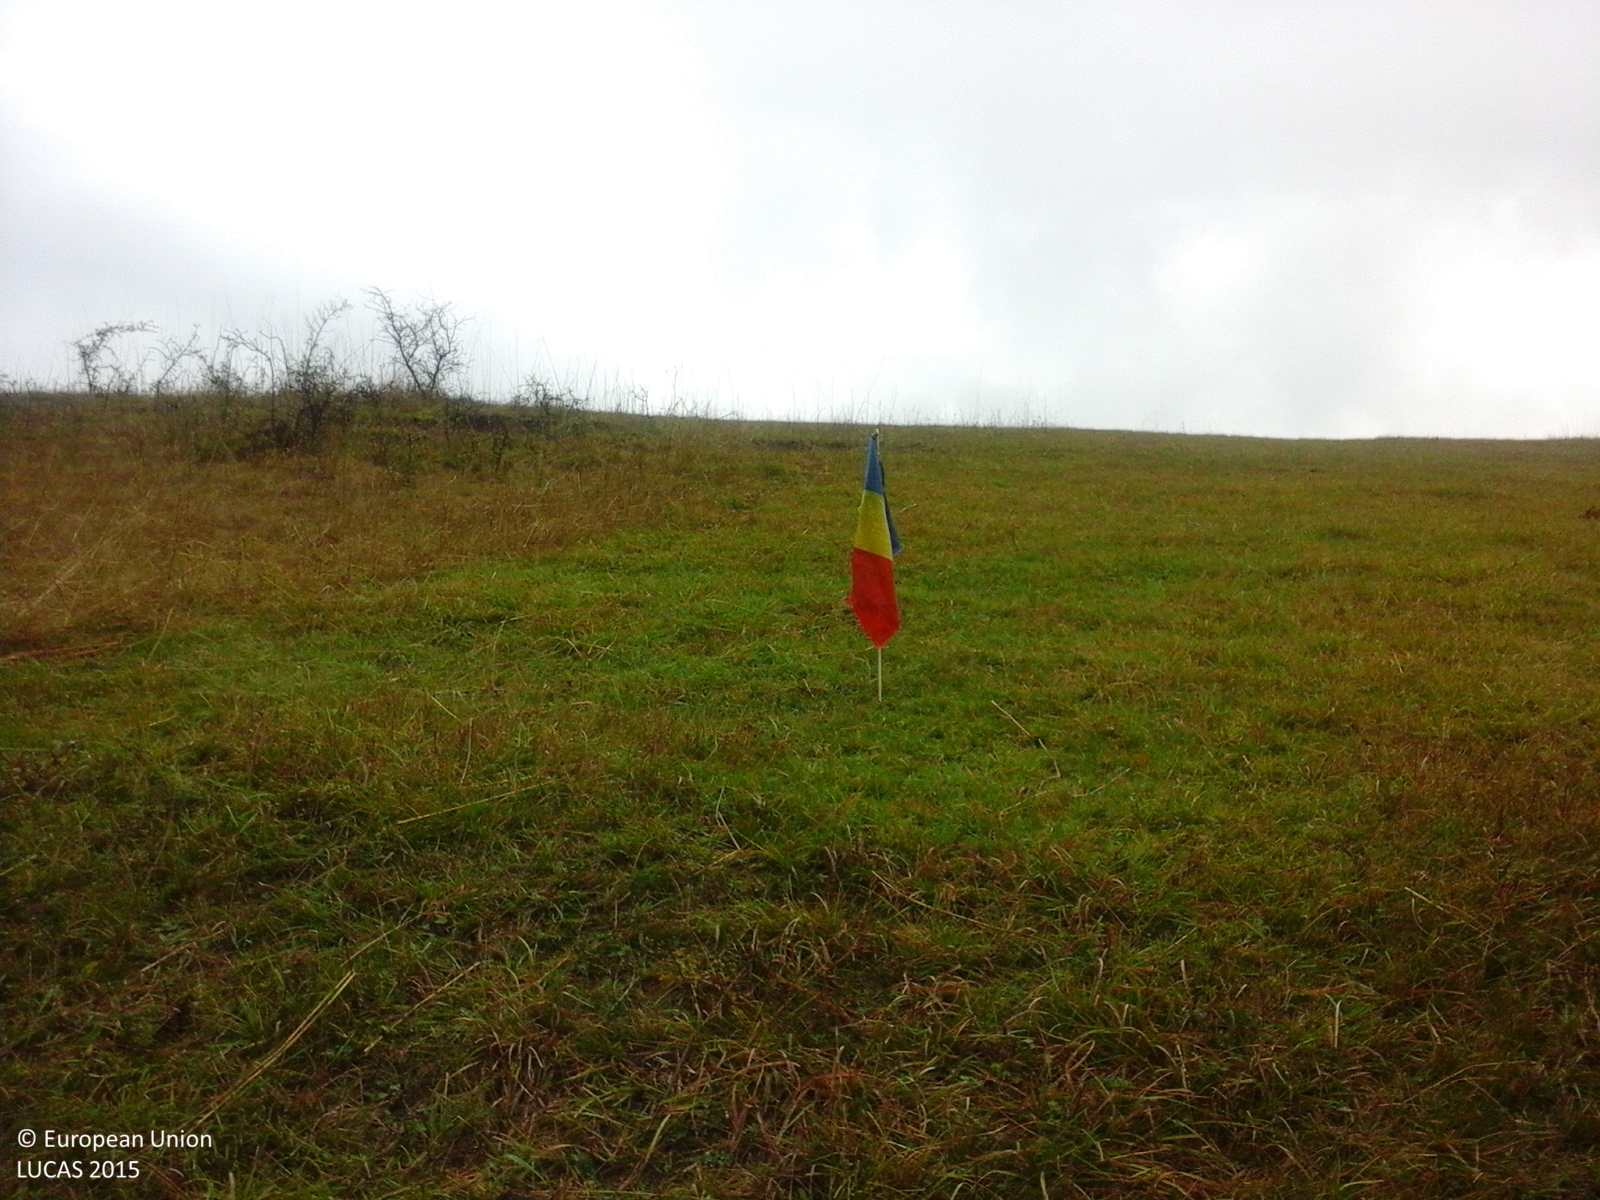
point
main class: Grassland
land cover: Grassland without tree/shrub cover
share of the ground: > 75 %
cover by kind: herbaceous plants 100 %
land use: Agriculture (excluding fallow land and kitchen gardens)
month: September
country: RO
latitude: 45.1516
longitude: 23.5806
